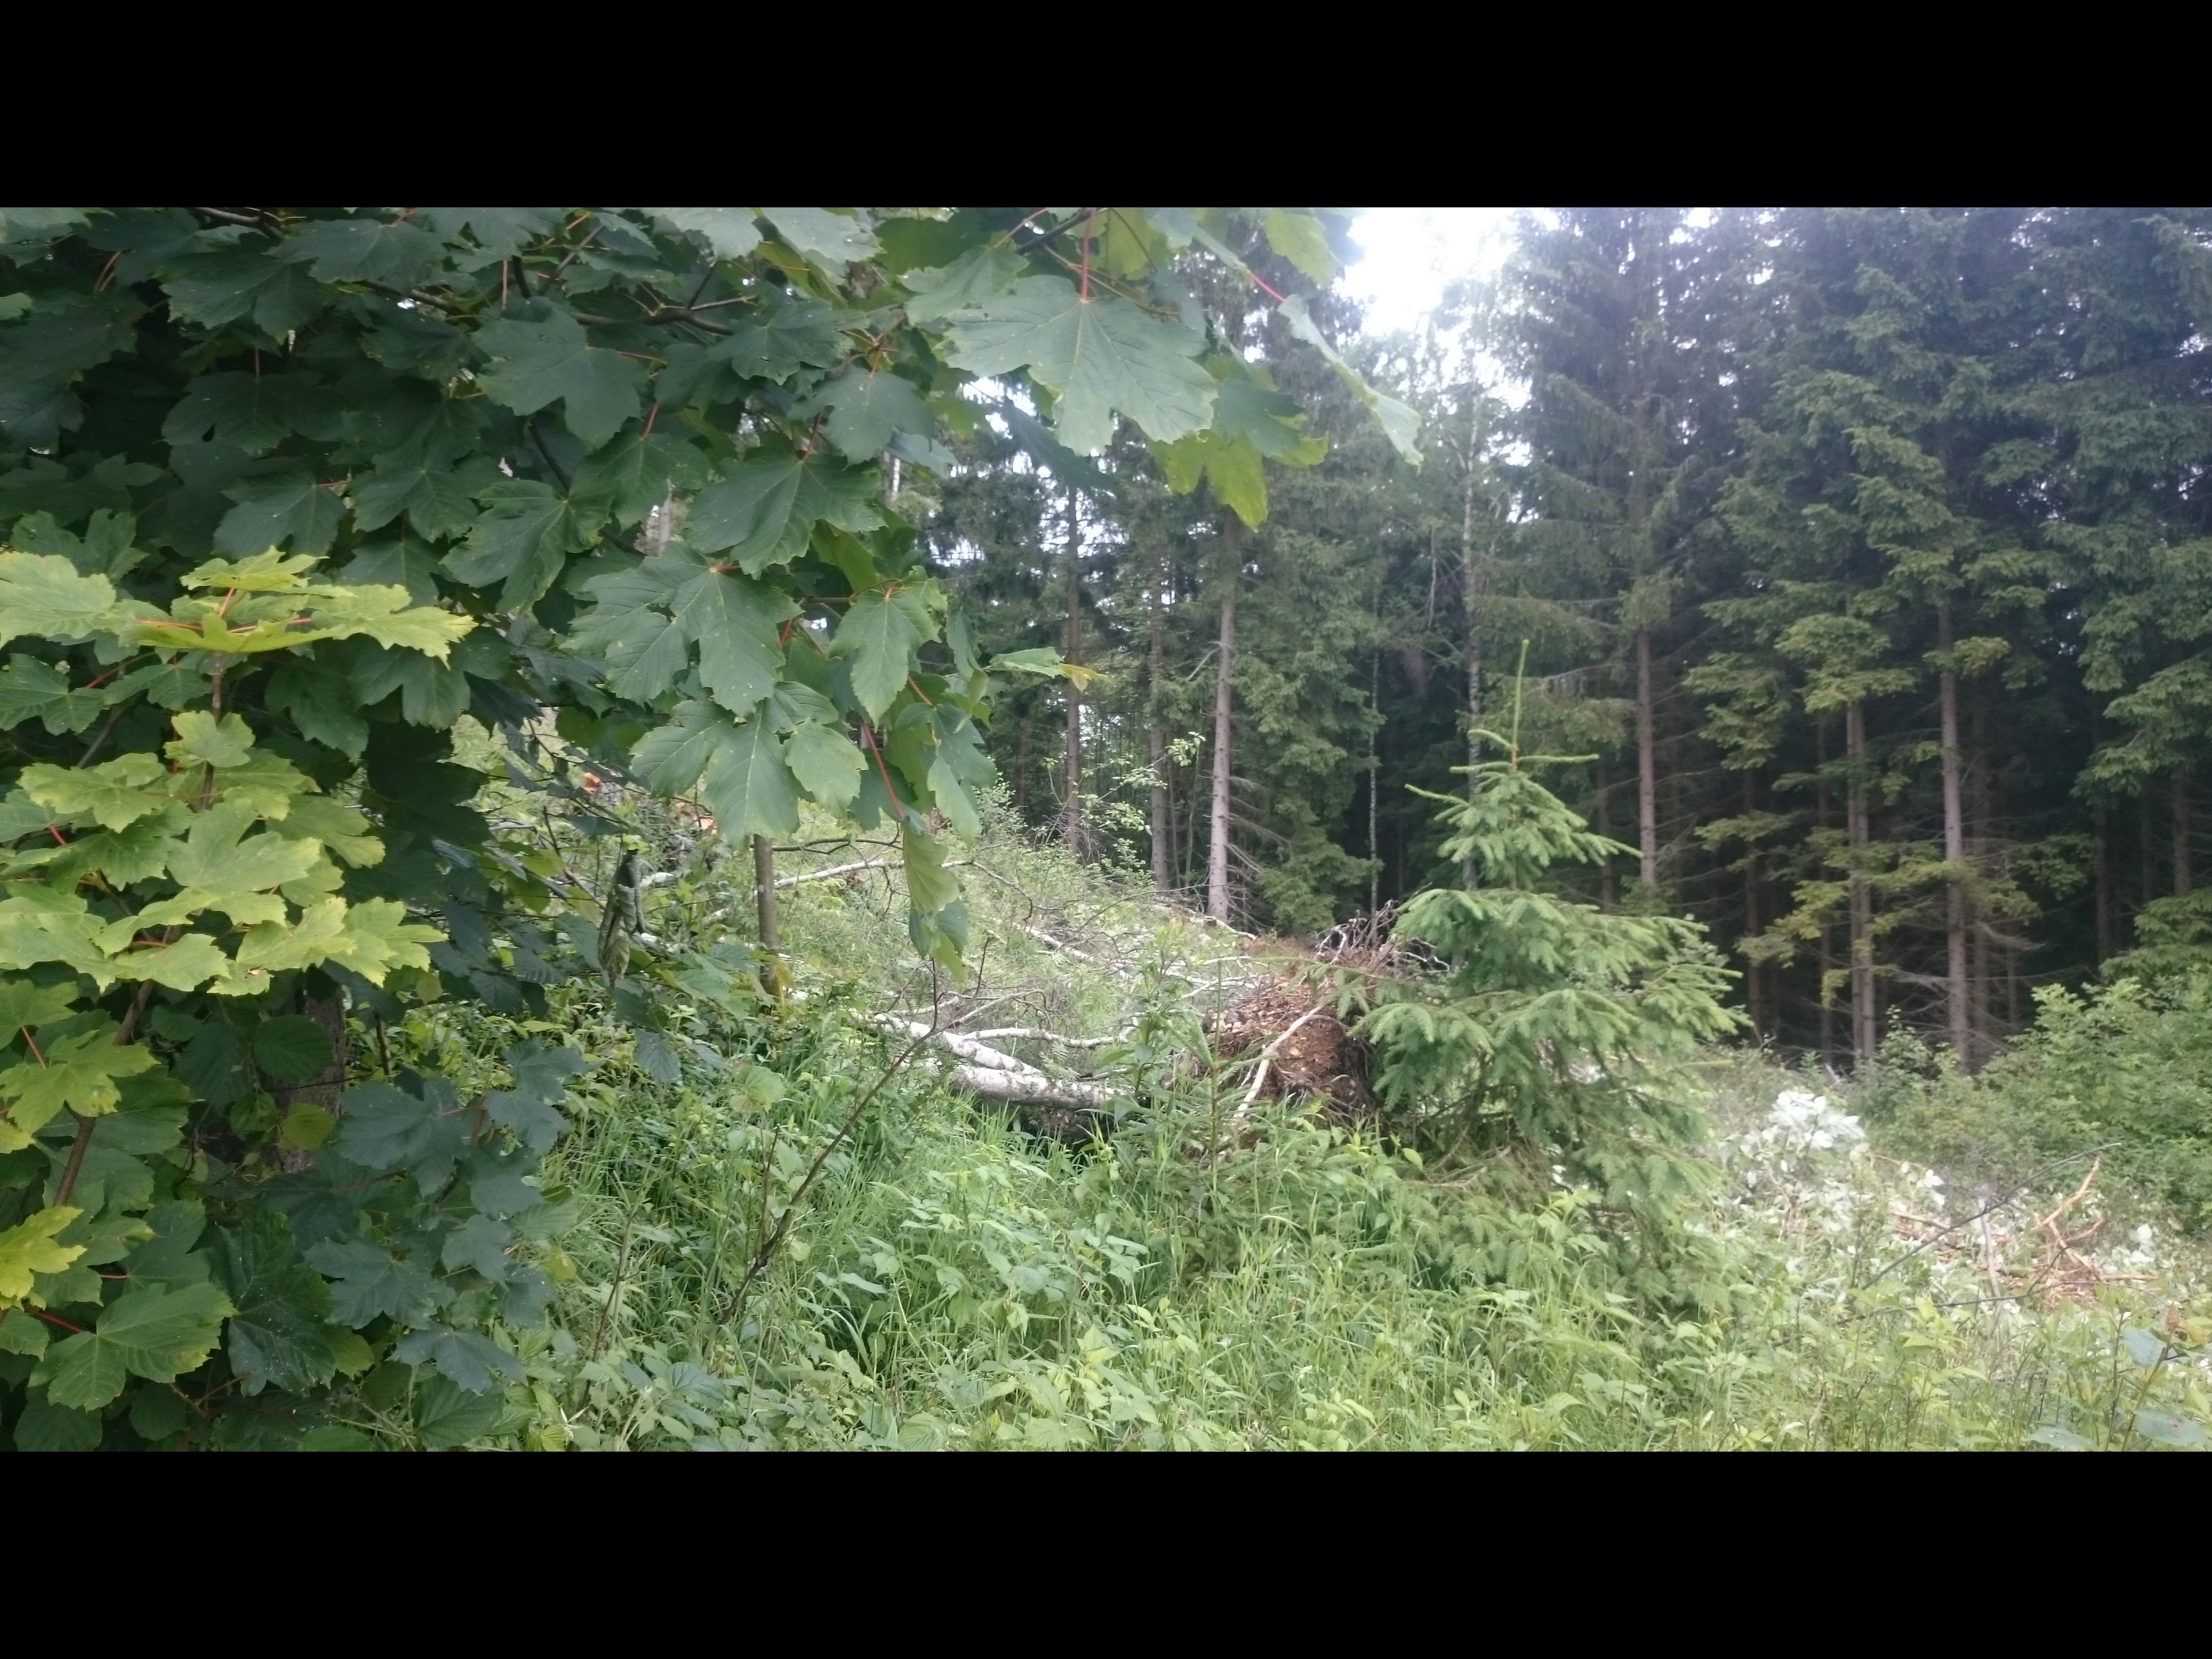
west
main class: Woodland
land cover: Broadleaved woodland
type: non-riverine alder, birch or aspen forest
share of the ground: 25 - 50 %
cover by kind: broadleaved forest trees 40 %, herbaceous plants 30 %, shrubs 25 %, coniferous forest trees 5 %
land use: Forestry
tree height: > 5 m
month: June
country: AT
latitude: 48.6230
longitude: 14.8175
